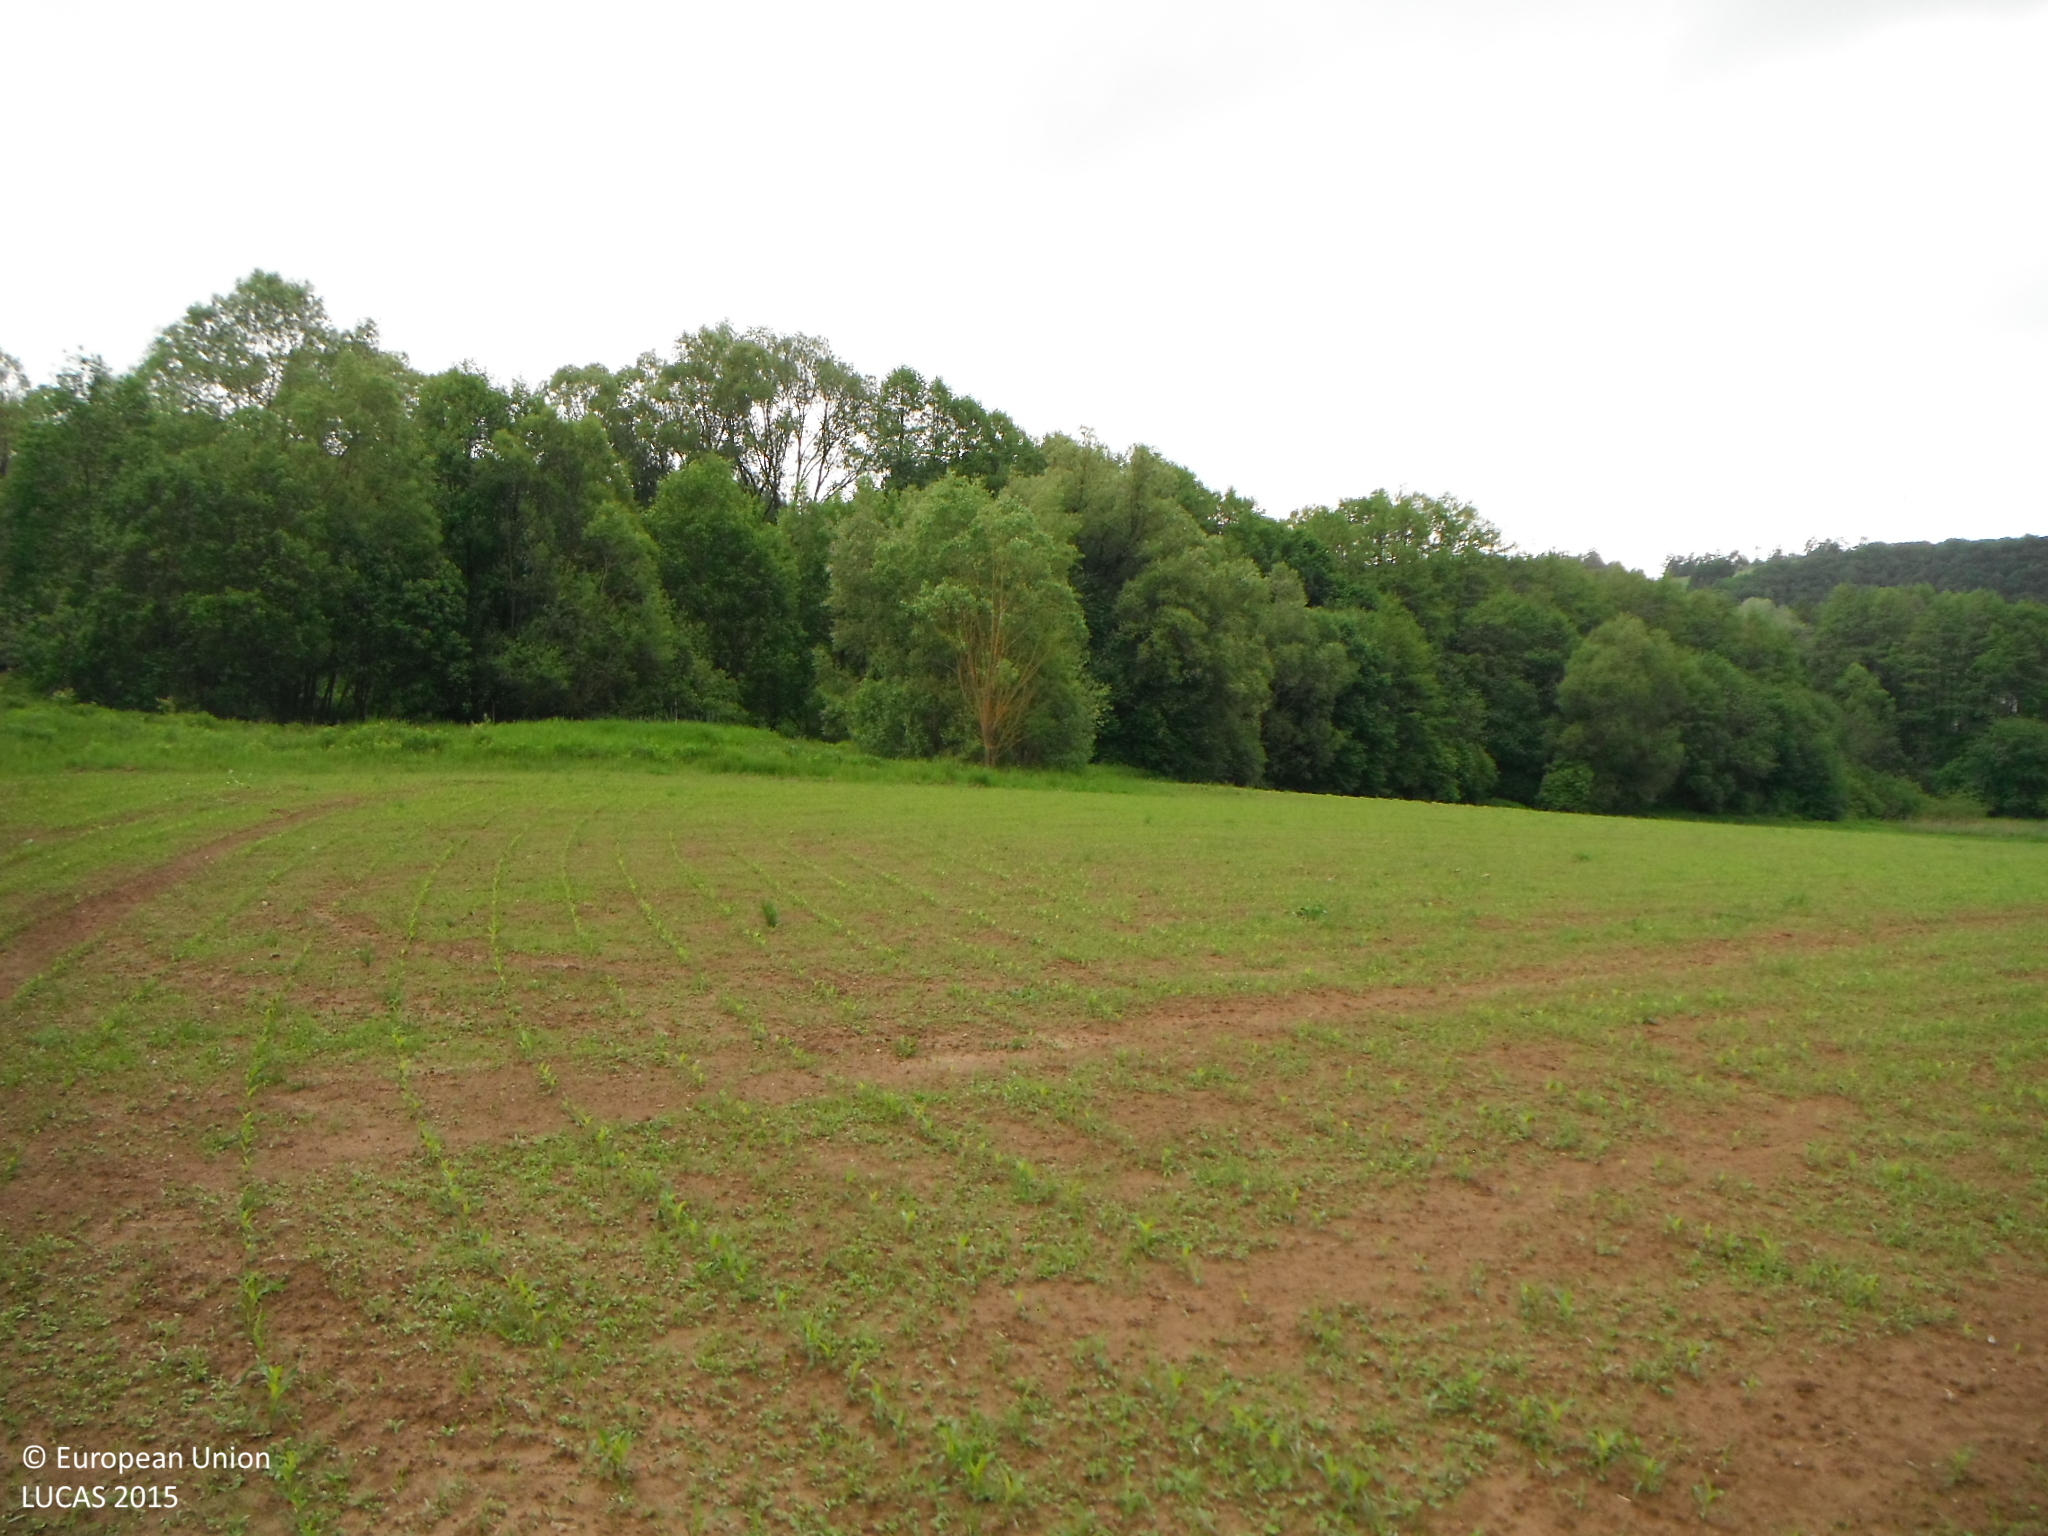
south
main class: Cropland
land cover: Maize
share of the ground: < 10 %
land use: Agriculture (excluding fallow land and kitchen gardens)
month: May
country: SK
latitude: 48.7411
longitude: 19.2291
